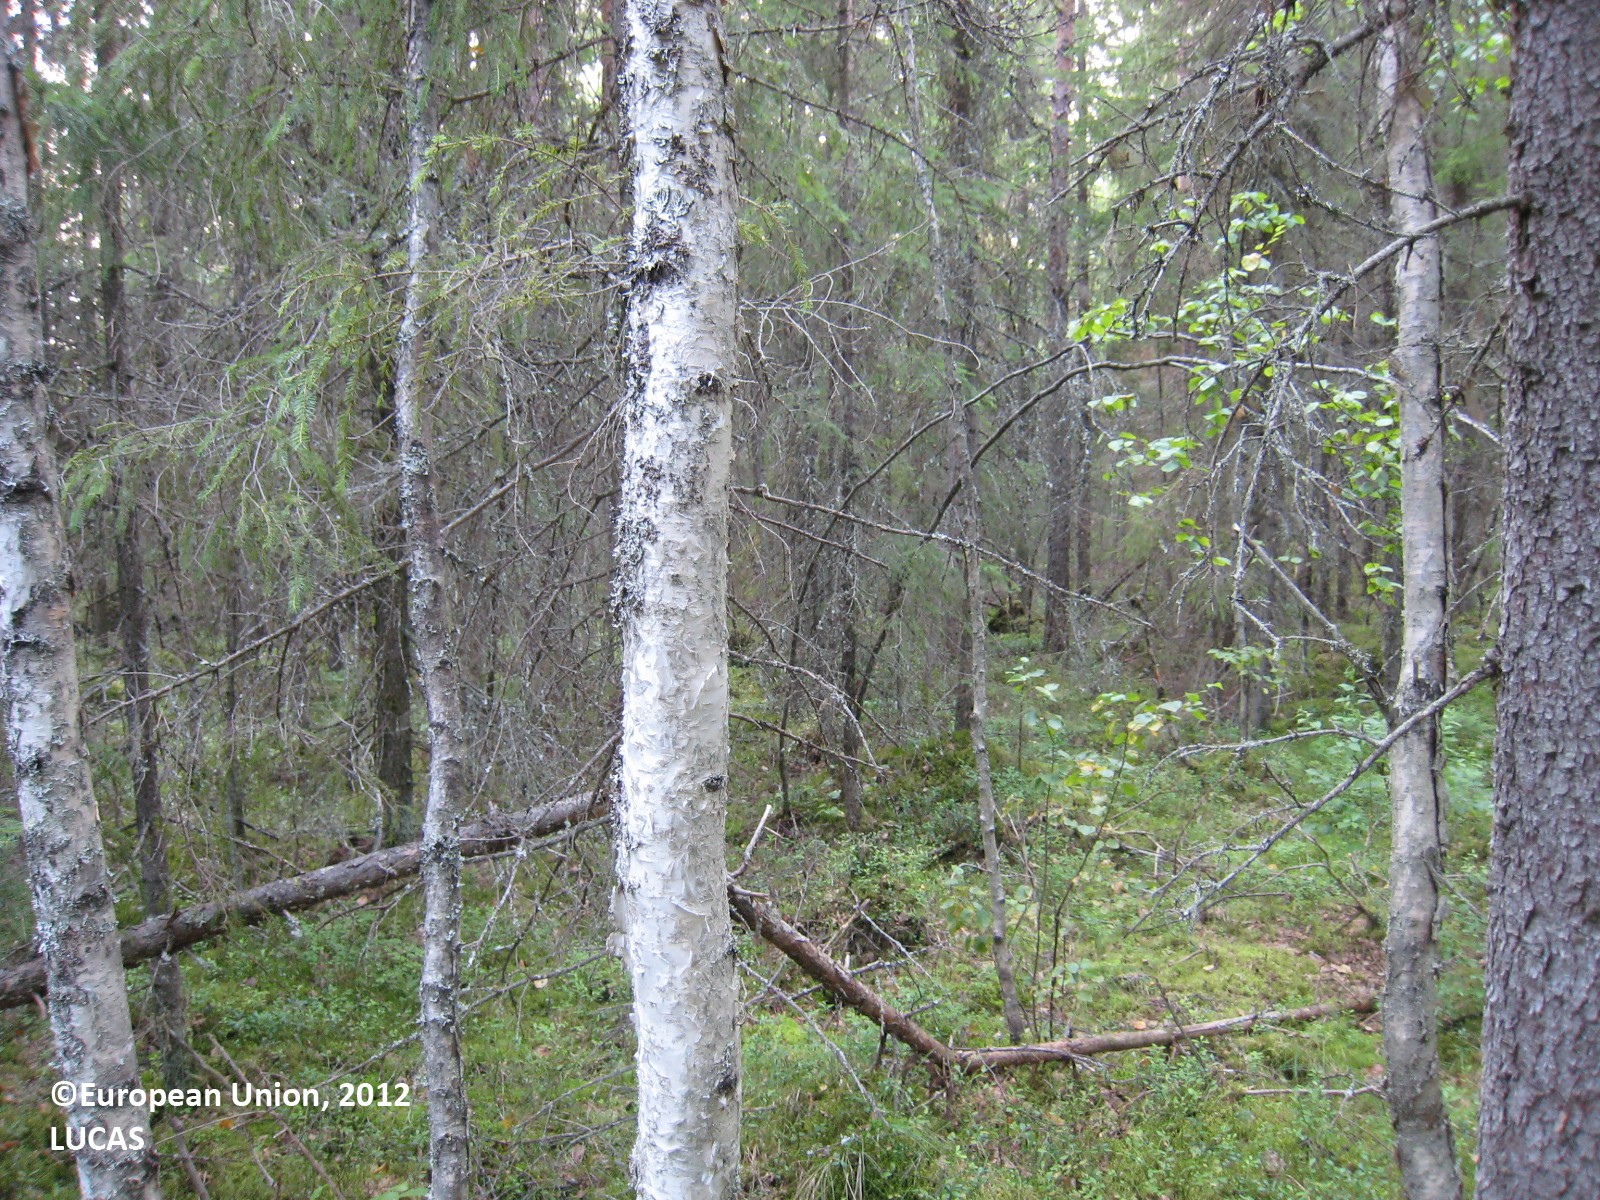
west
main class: Woodland
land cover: Other mixed woodland
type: boreal forest
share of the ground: > 75 %
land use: Forestry
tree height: > 5 m
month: July
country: FI
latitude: 62.6154
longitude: 27.3295
